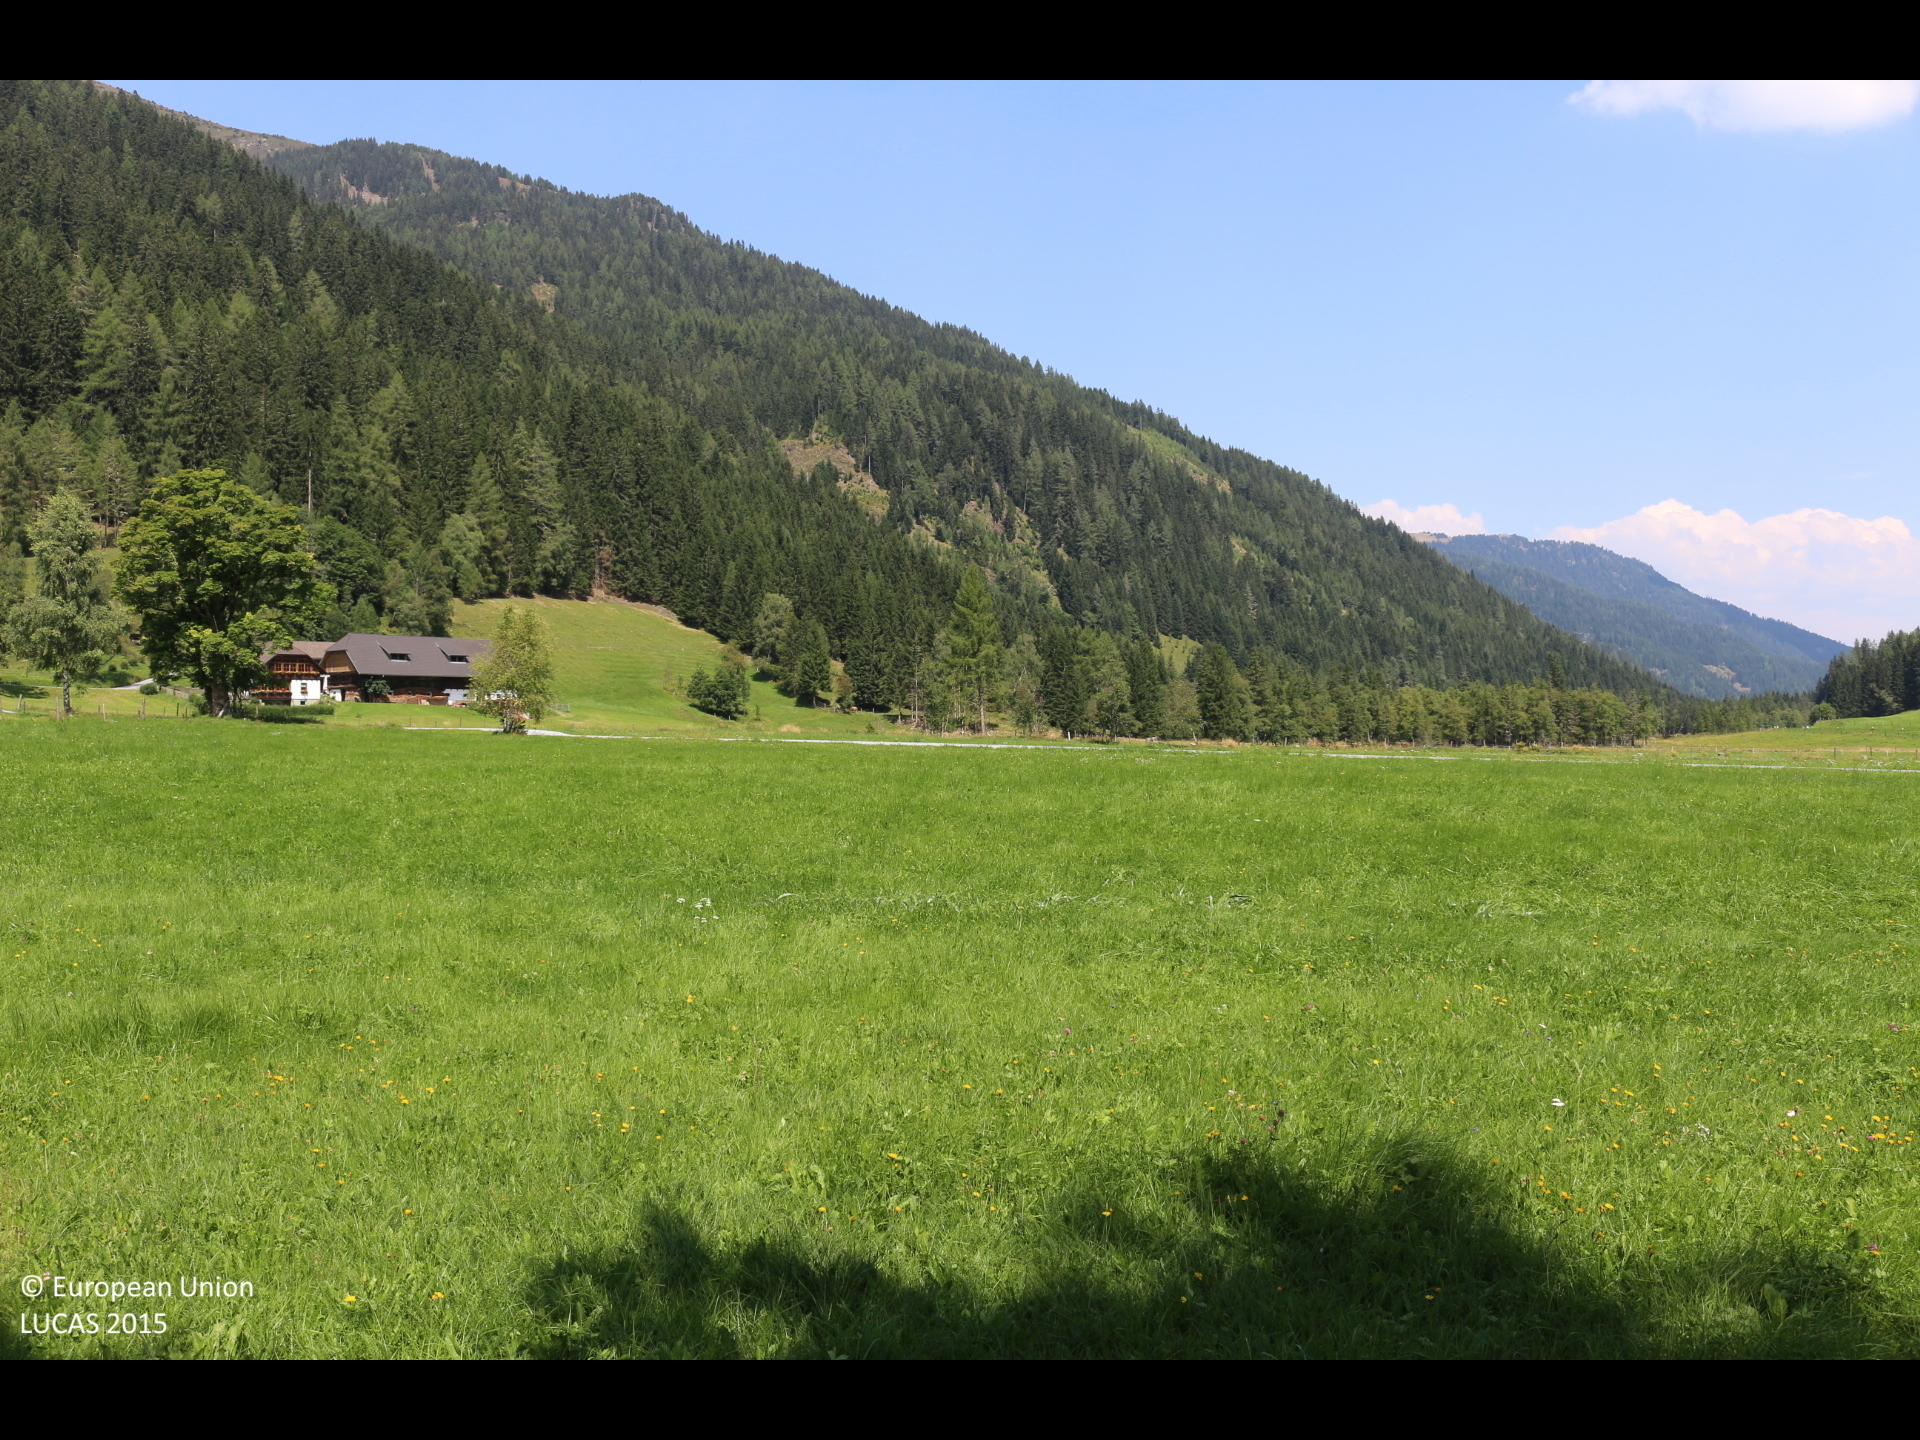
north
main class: Grassland
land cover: Grassland without tree/shrub cover
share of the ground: > 75 %
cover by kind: herbaceous plants 100 %
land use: Agriculture (excluding fallow land and kitchen gardens)
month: August
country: AT
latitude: 47.0283
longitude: 14.1428
